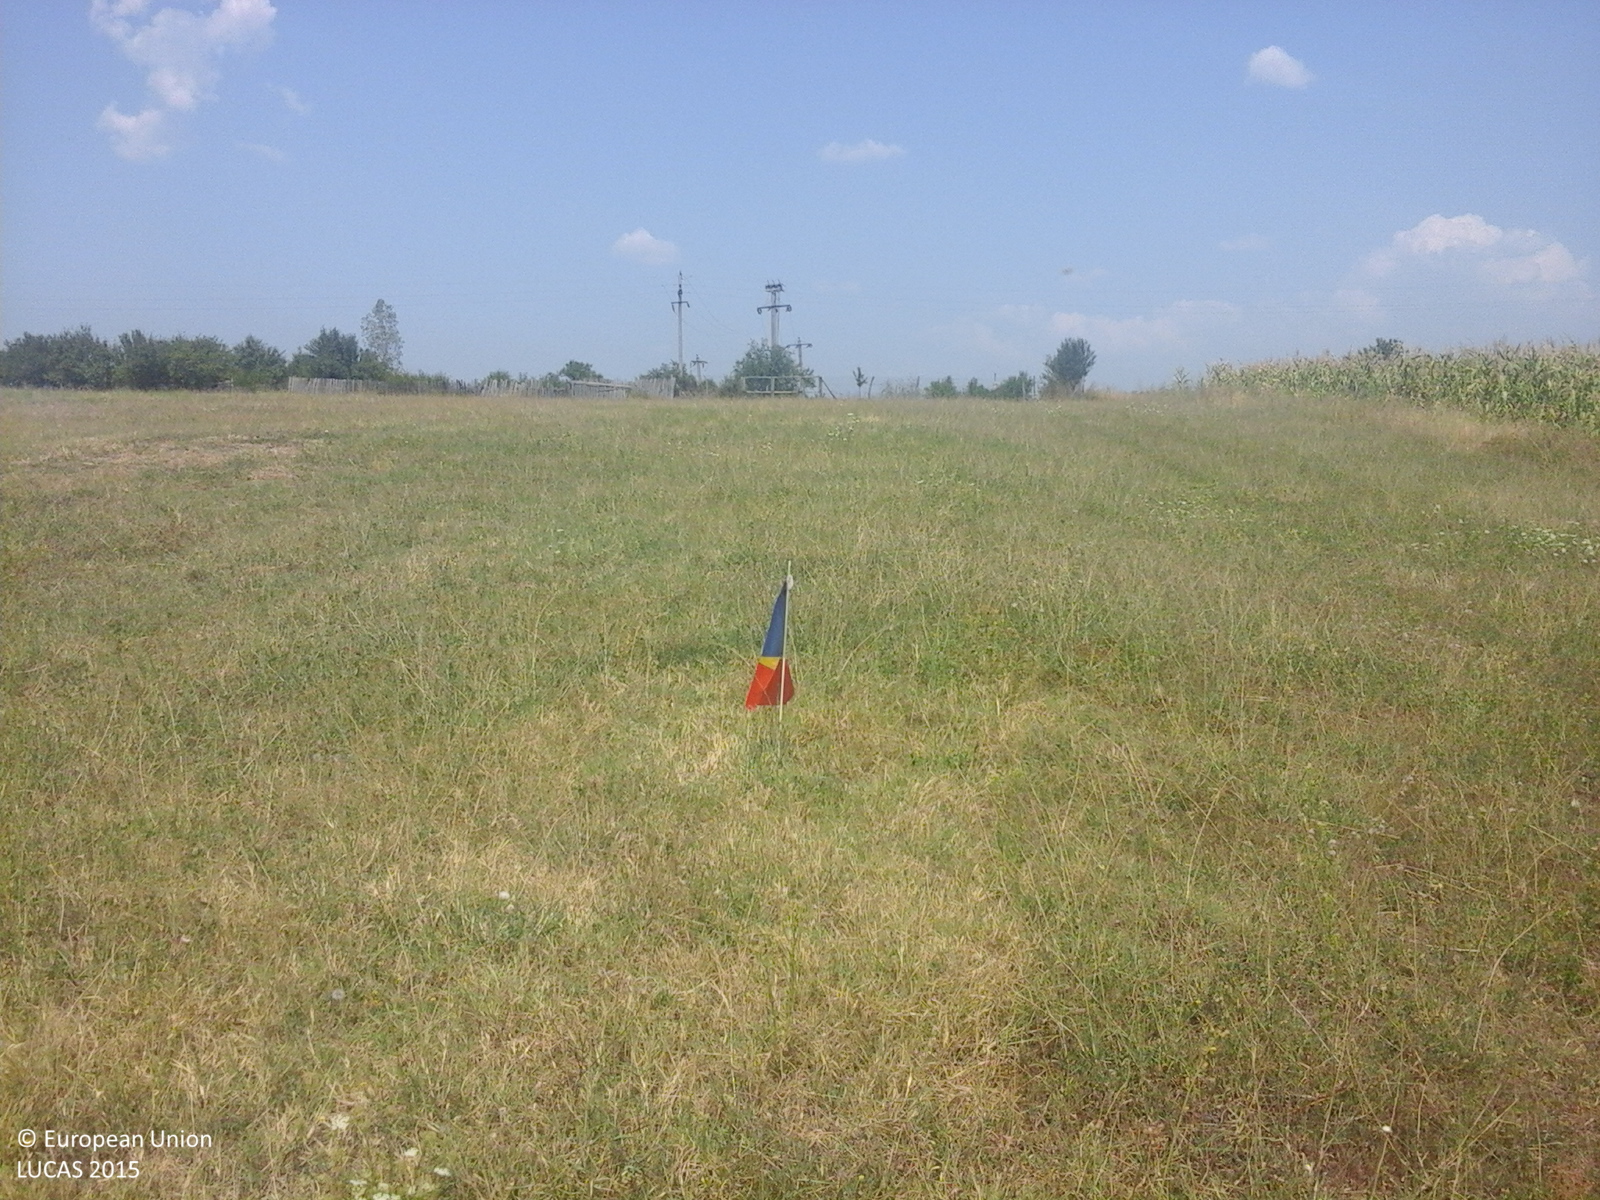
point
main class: Grassland
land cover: Grassland without tree/shrub cover
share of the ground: > 75 %
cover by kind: herbaceous plants 100 %
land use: Agriculture (excluding fallow land and kitchen gardens)
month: August
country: RO
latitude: 44.5112
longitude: 23.1684
